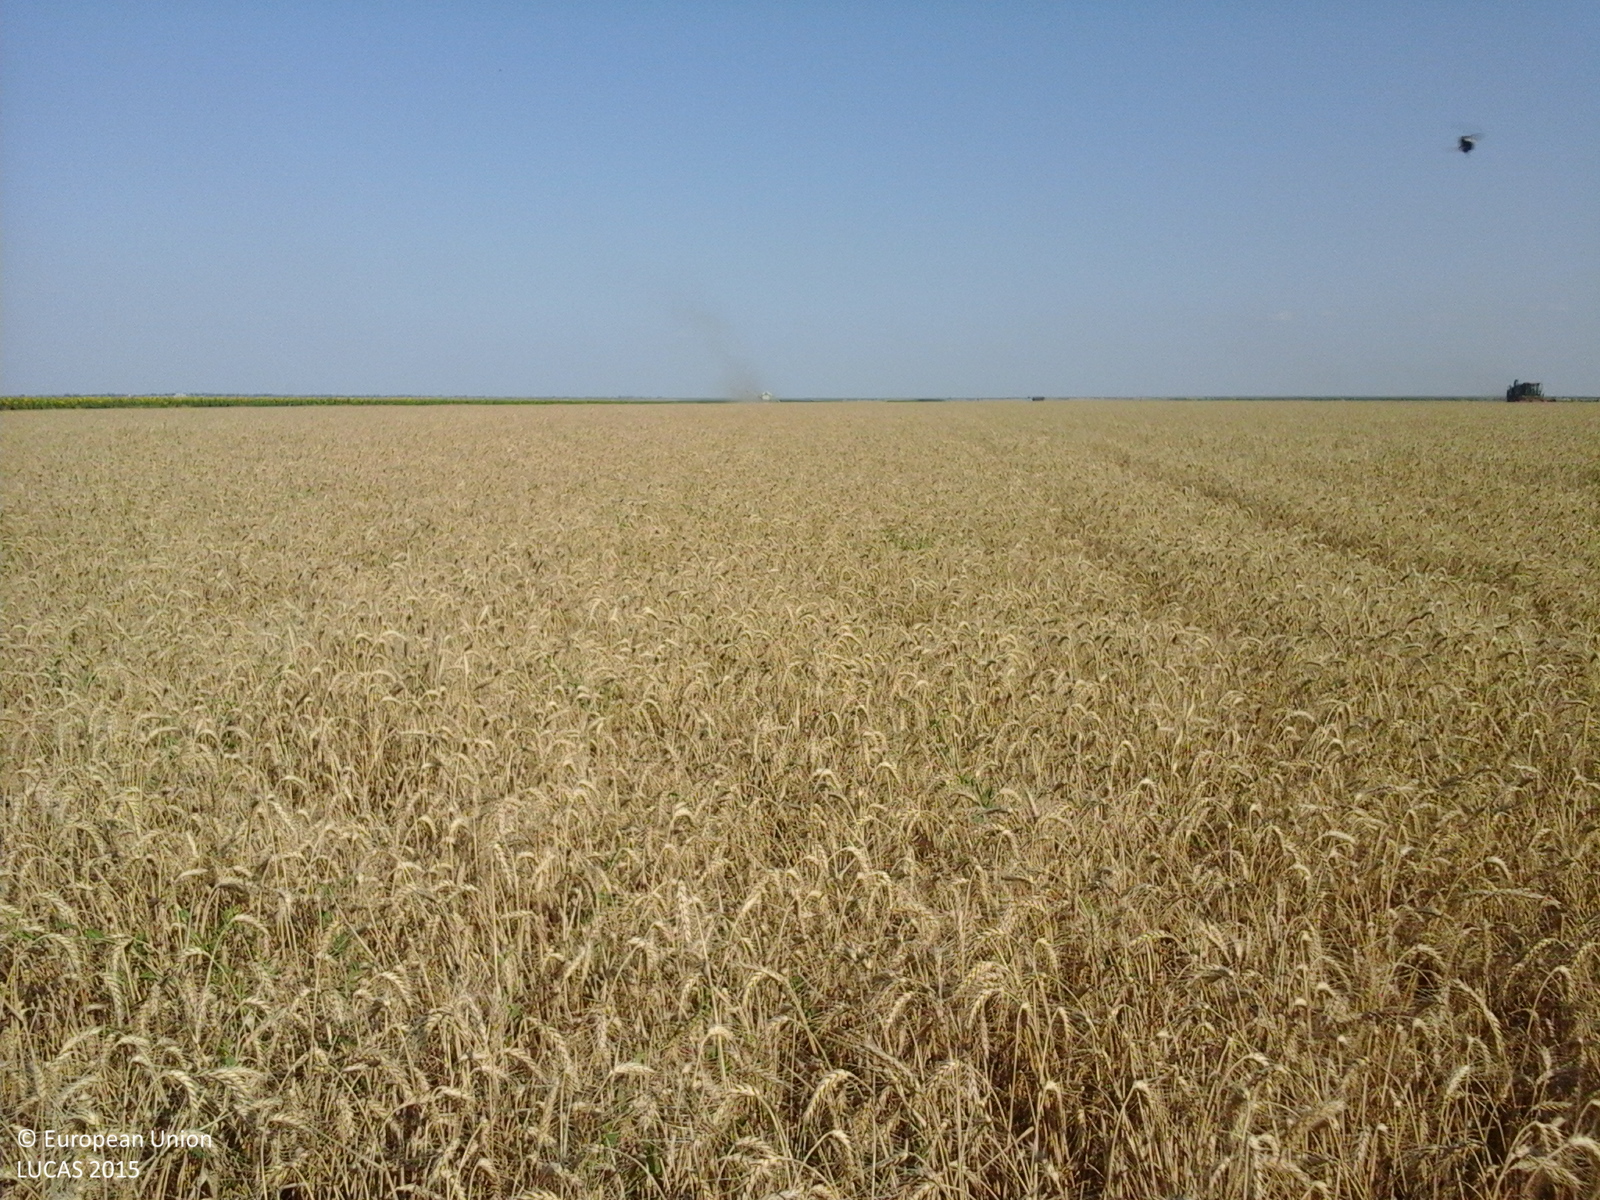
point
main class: Cropland
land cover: Common wheat
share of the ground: > 75 %
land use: Agriculture (excluding fallow land and kitchen gardens)
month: July
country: RO
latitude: 44.2895
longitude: 24.6722
